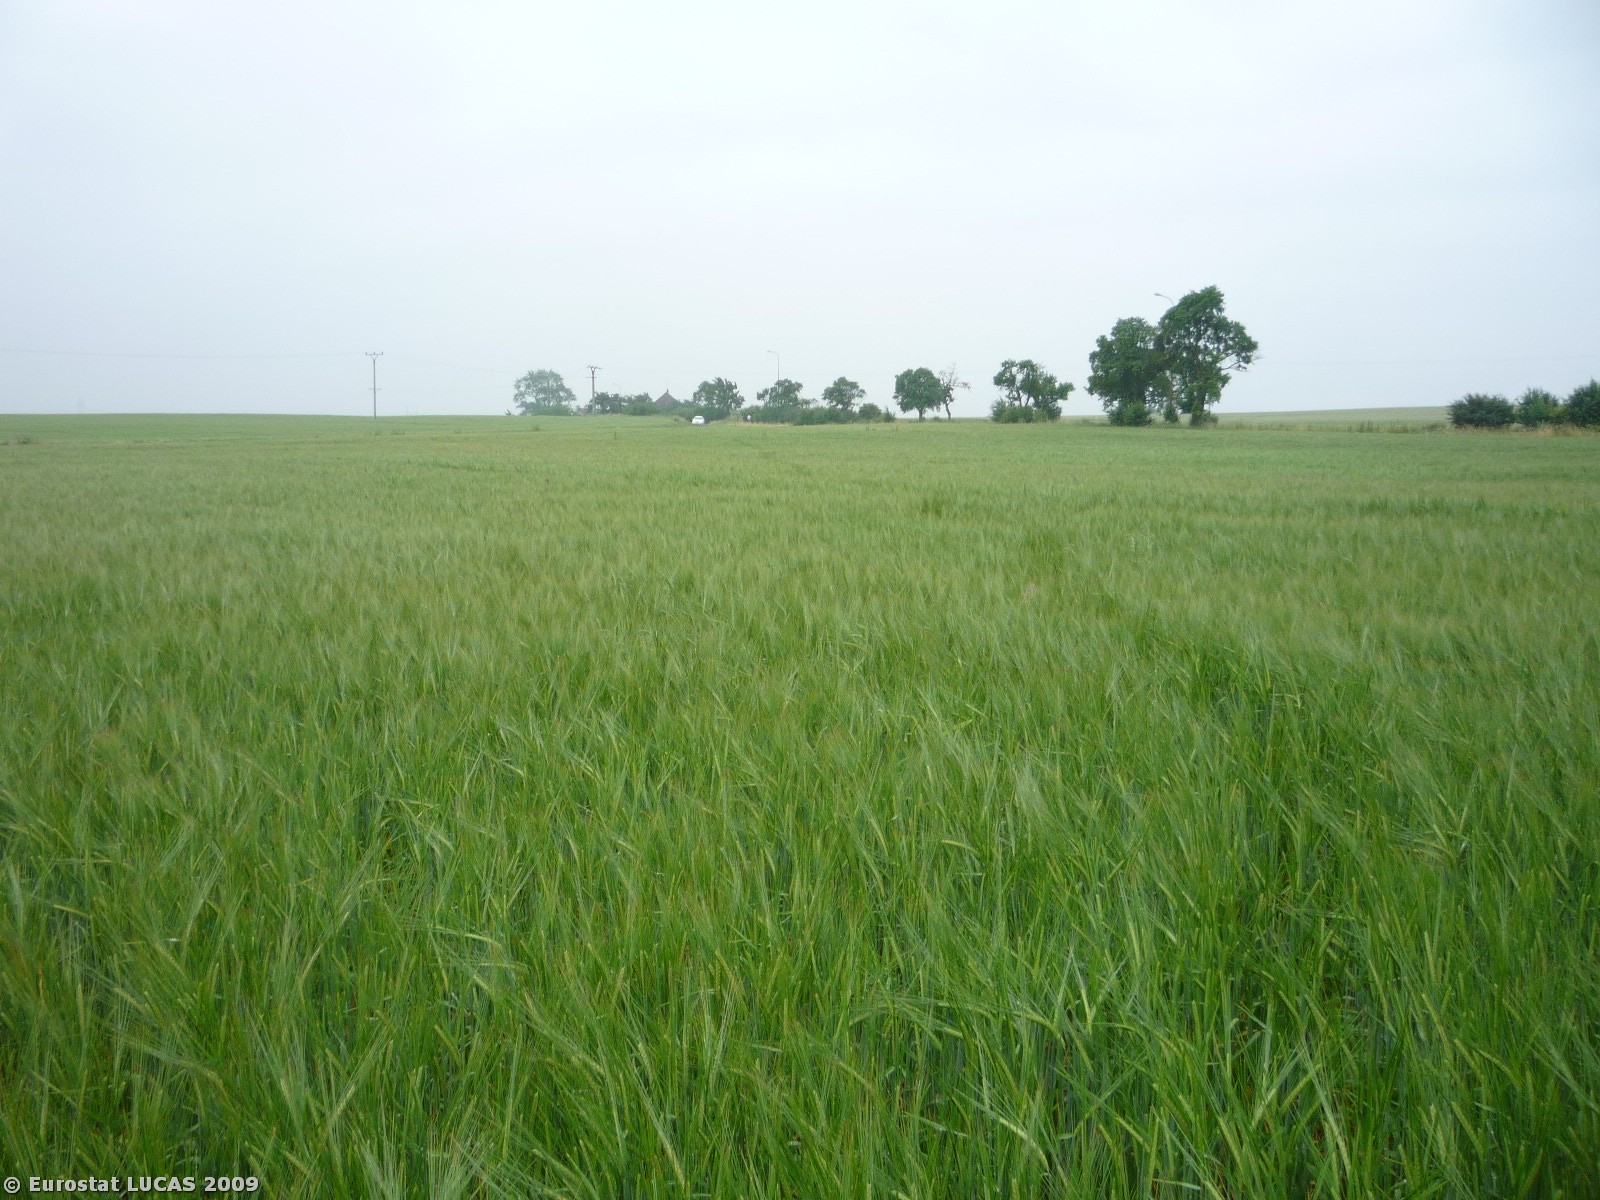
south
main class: Cropland
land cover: Barley
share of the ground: > 75 %
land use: Agriculture (excluding fallow land and kitchen gardens)
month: June
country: CZ
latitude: 50.1145
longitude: 14.9111
